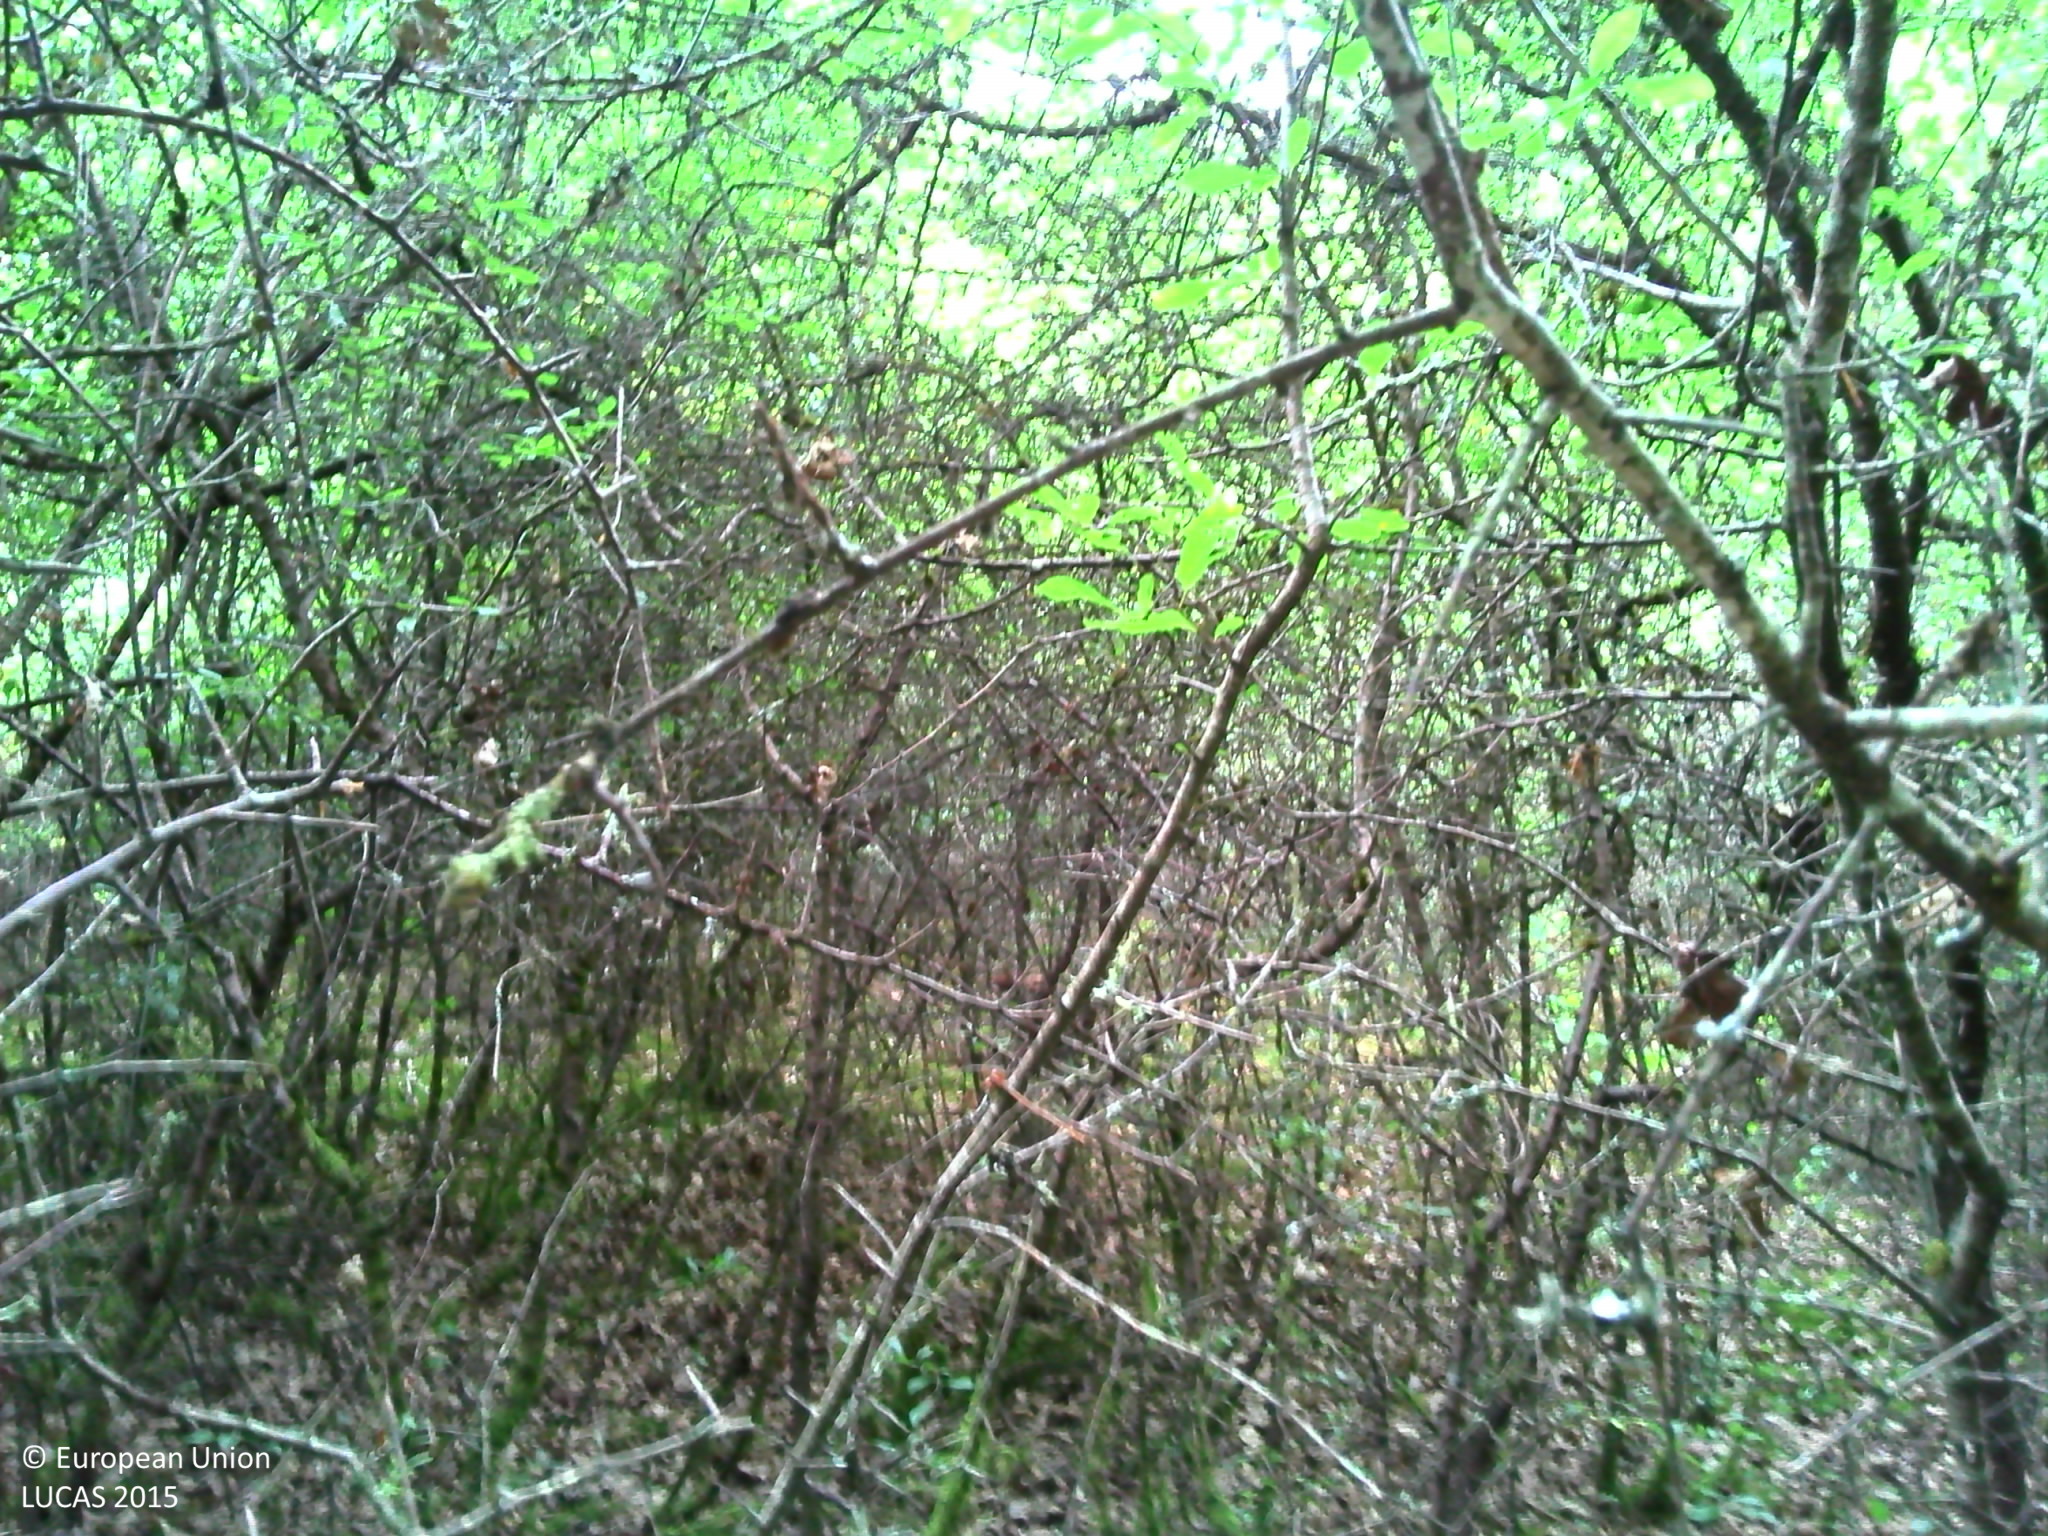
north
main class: Woodland
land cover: Broadleaved woodland
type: acidophilous oak and oak-birch forest
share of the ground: > 75 %
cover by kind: broadleaved forest trees 70 %, shrubs 15 %, herbaceous plants 10 %, lichens and mosses 5 %
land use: Forestry
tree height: > 5 m
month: July
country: FR
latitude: 45.0241
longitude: 0.7392
